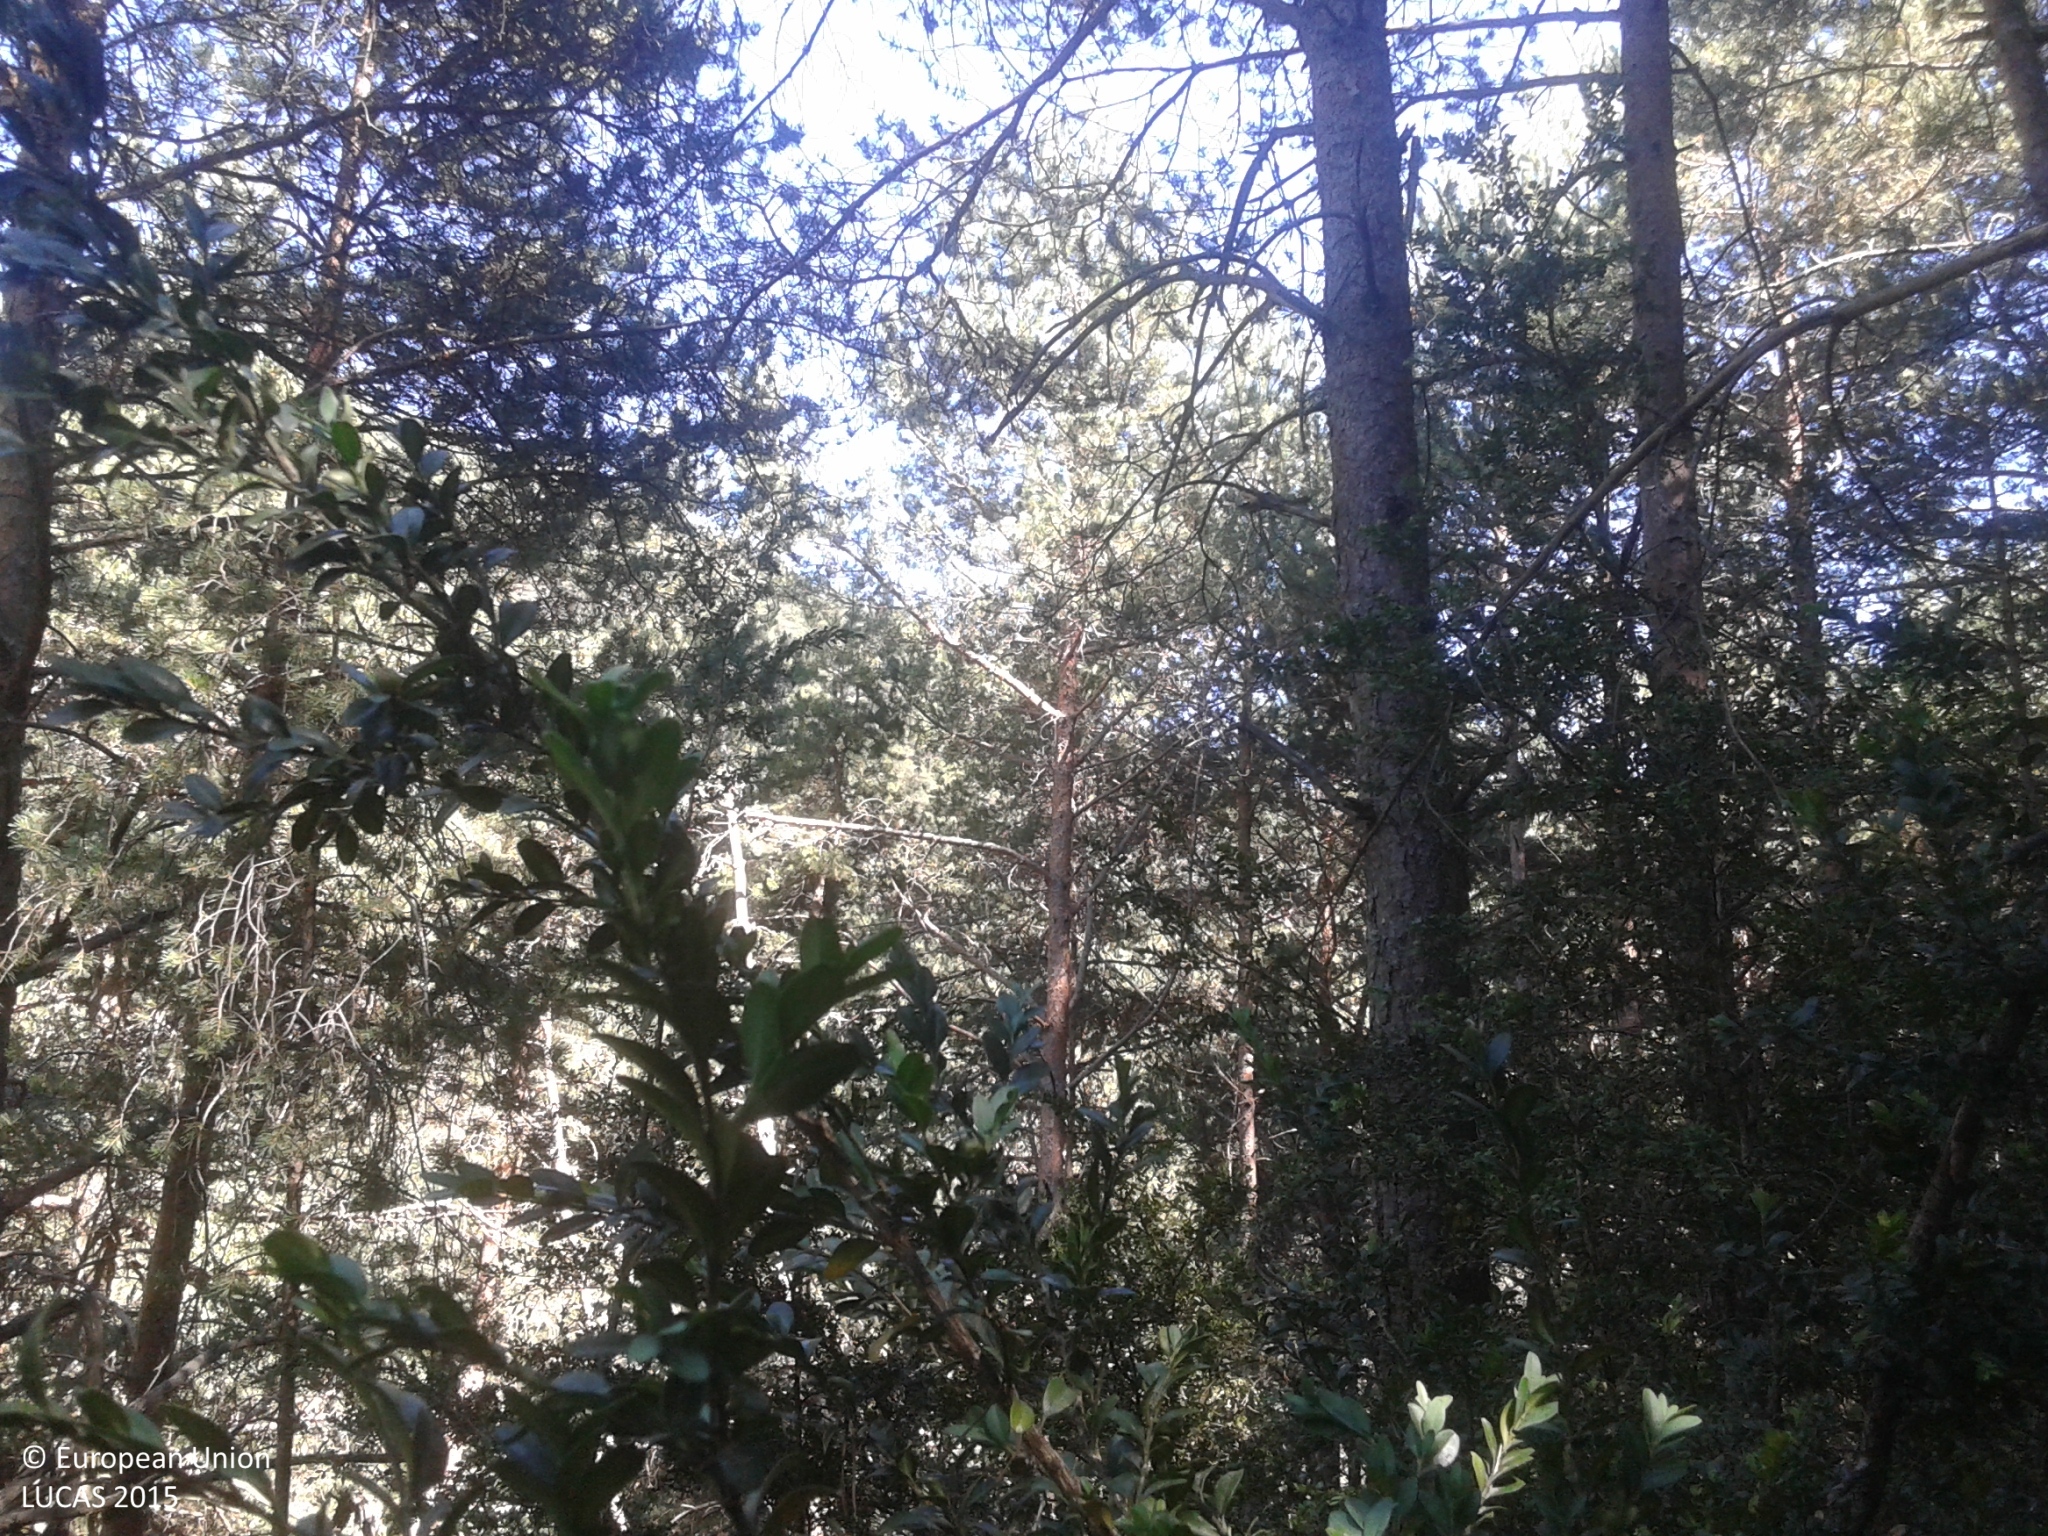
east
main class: Woodland
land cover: Pine dominated coniferous woodland
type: alpine coniferous forest
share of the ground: 50 - 75 %
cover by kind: coniferous forest trees 70 %, shrubs 30 %
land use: Semi-natural and natural areas not in use
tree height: > 5 m
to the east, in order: Pine dominated coniferous woodland; Rivers and streams; Pine dominated coniferous woodland; Rivers and streams; Pine dominated coniferous woodland
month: July
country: ES
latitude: 42.3168
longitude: 1.5294
